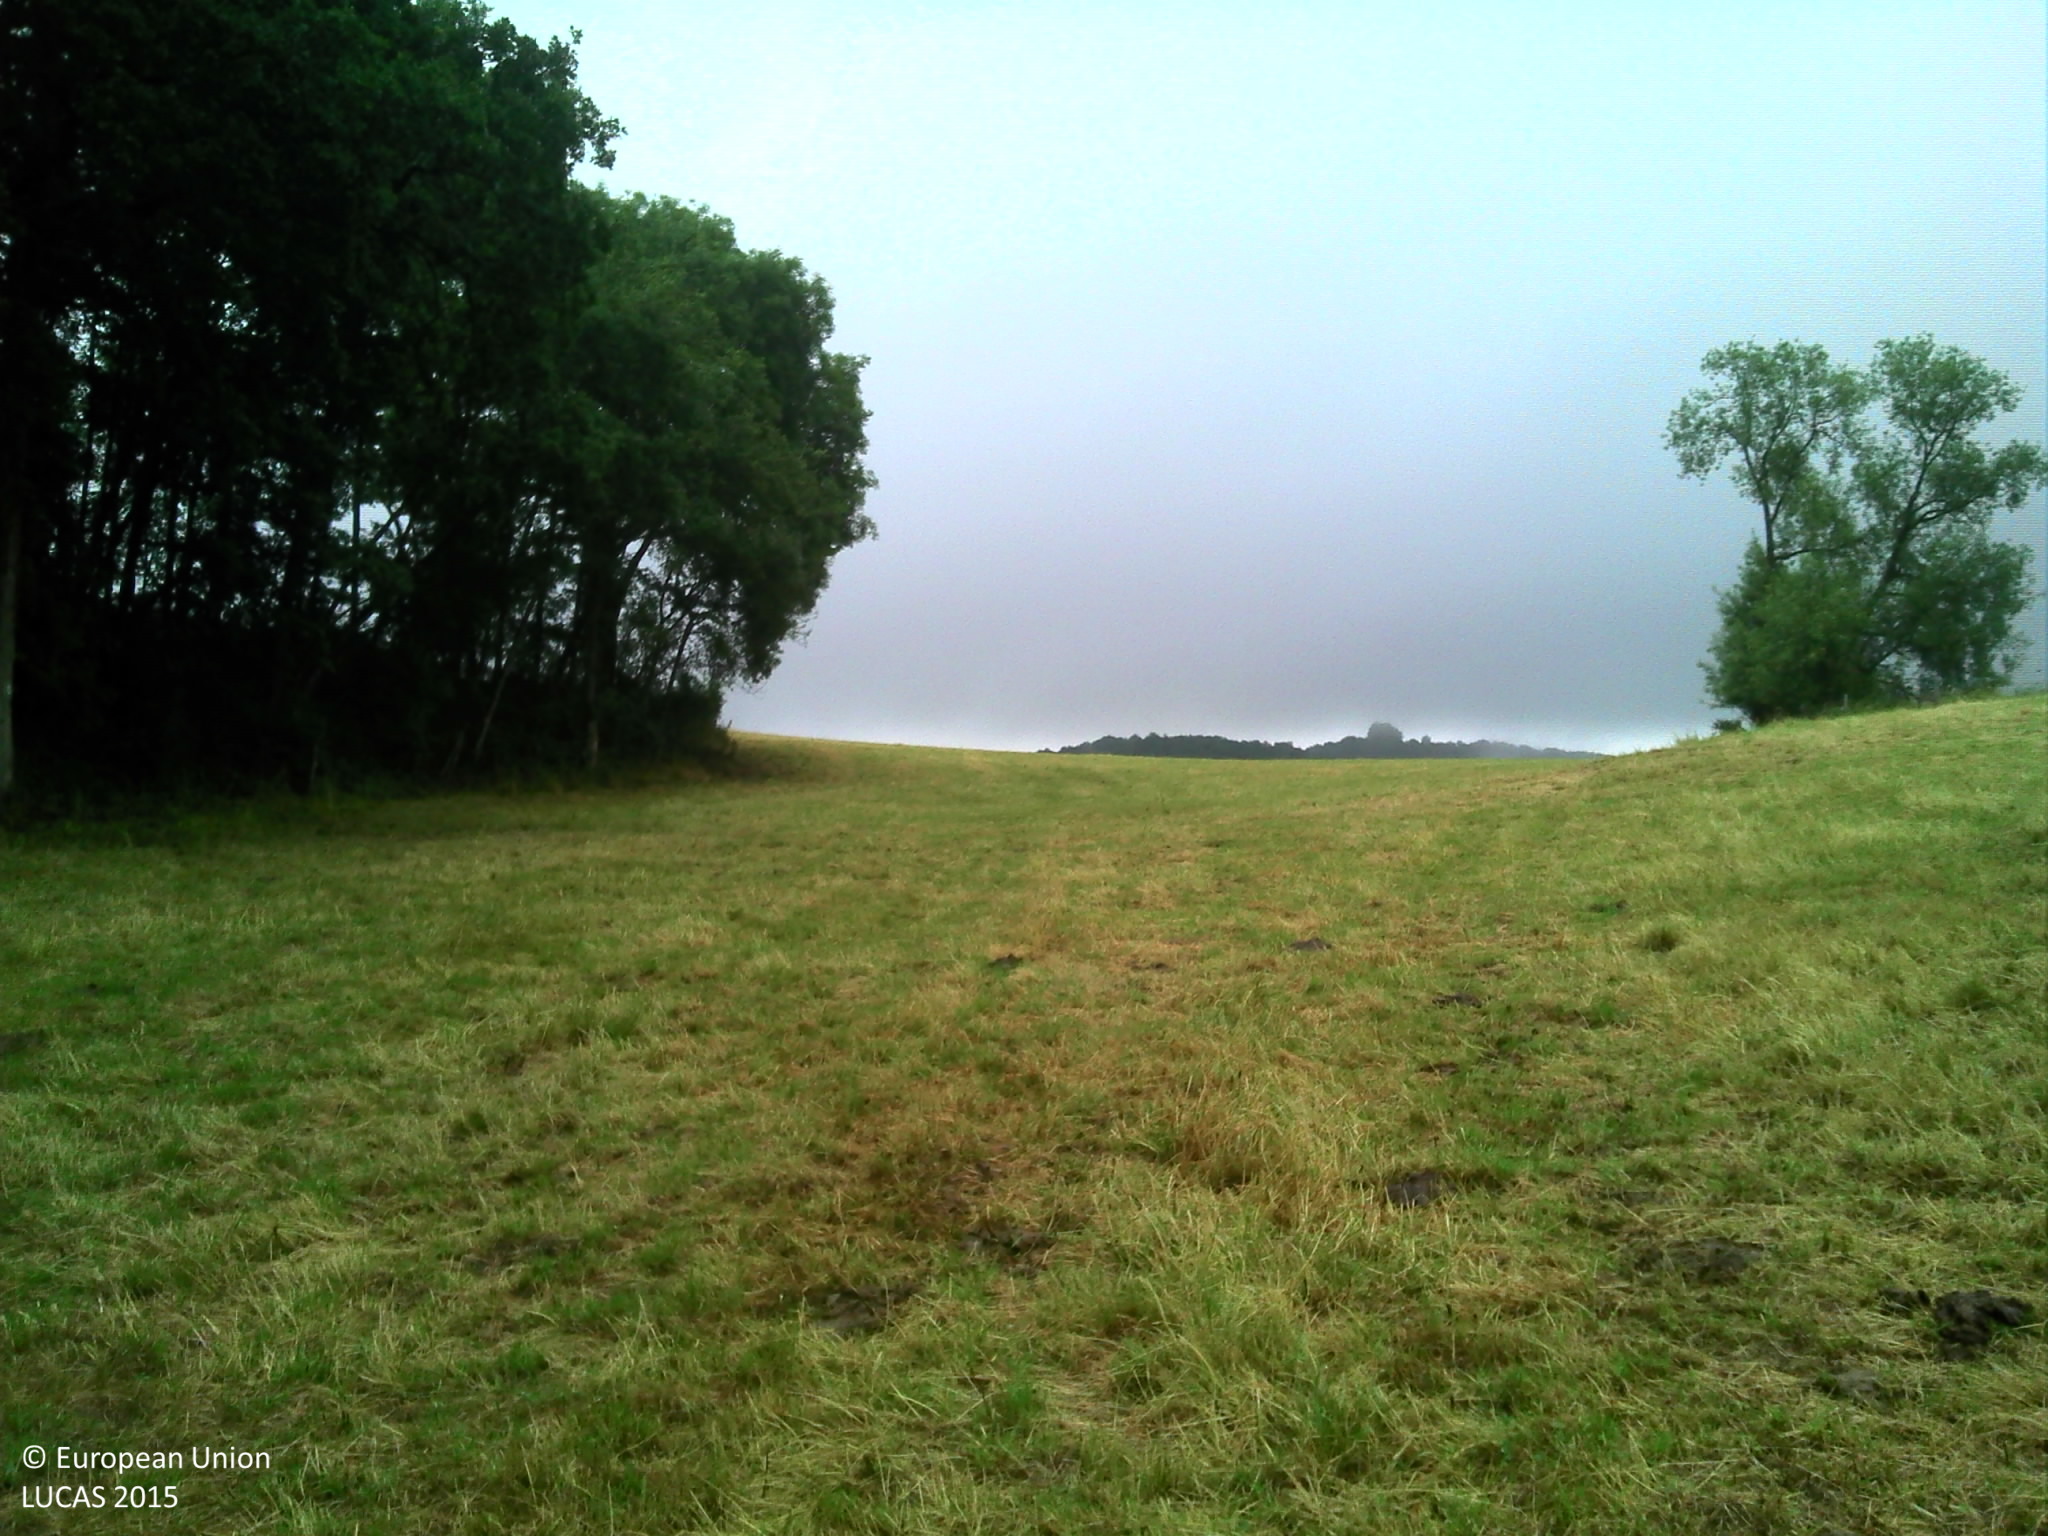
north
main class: Grassland
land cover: Grassland without tree/shrub cover
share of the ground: > 75 %
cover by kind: herbaceous plants 100 %
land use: Agriculture (excluding fallow land and kitchen gardens)
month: June
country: BE
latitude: 50.2753
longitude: 5.4941
